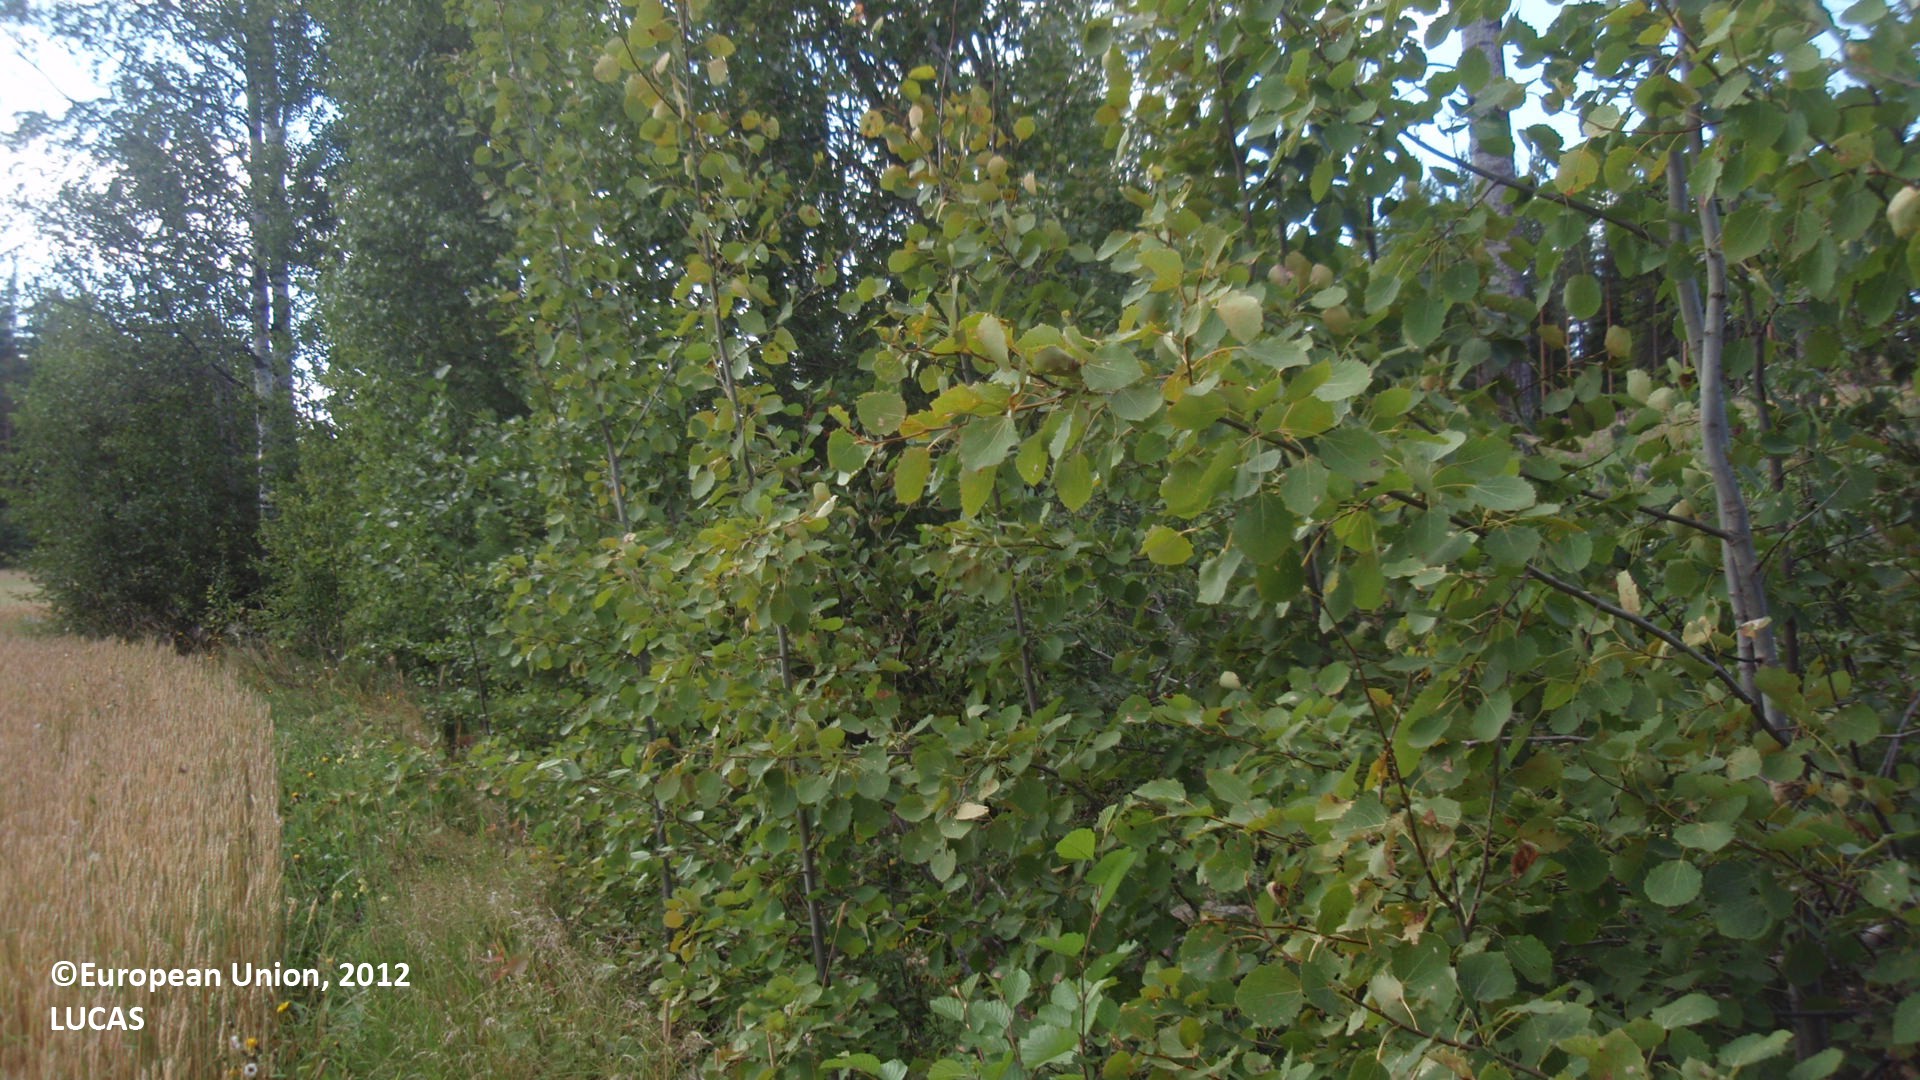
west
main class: Cropland
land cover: Common wheat
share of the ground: > 75 %
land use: Agriculture (excluding fallow land and kitchen gardens)
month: August
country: FI
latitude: 60.6854
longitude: 27.4877
